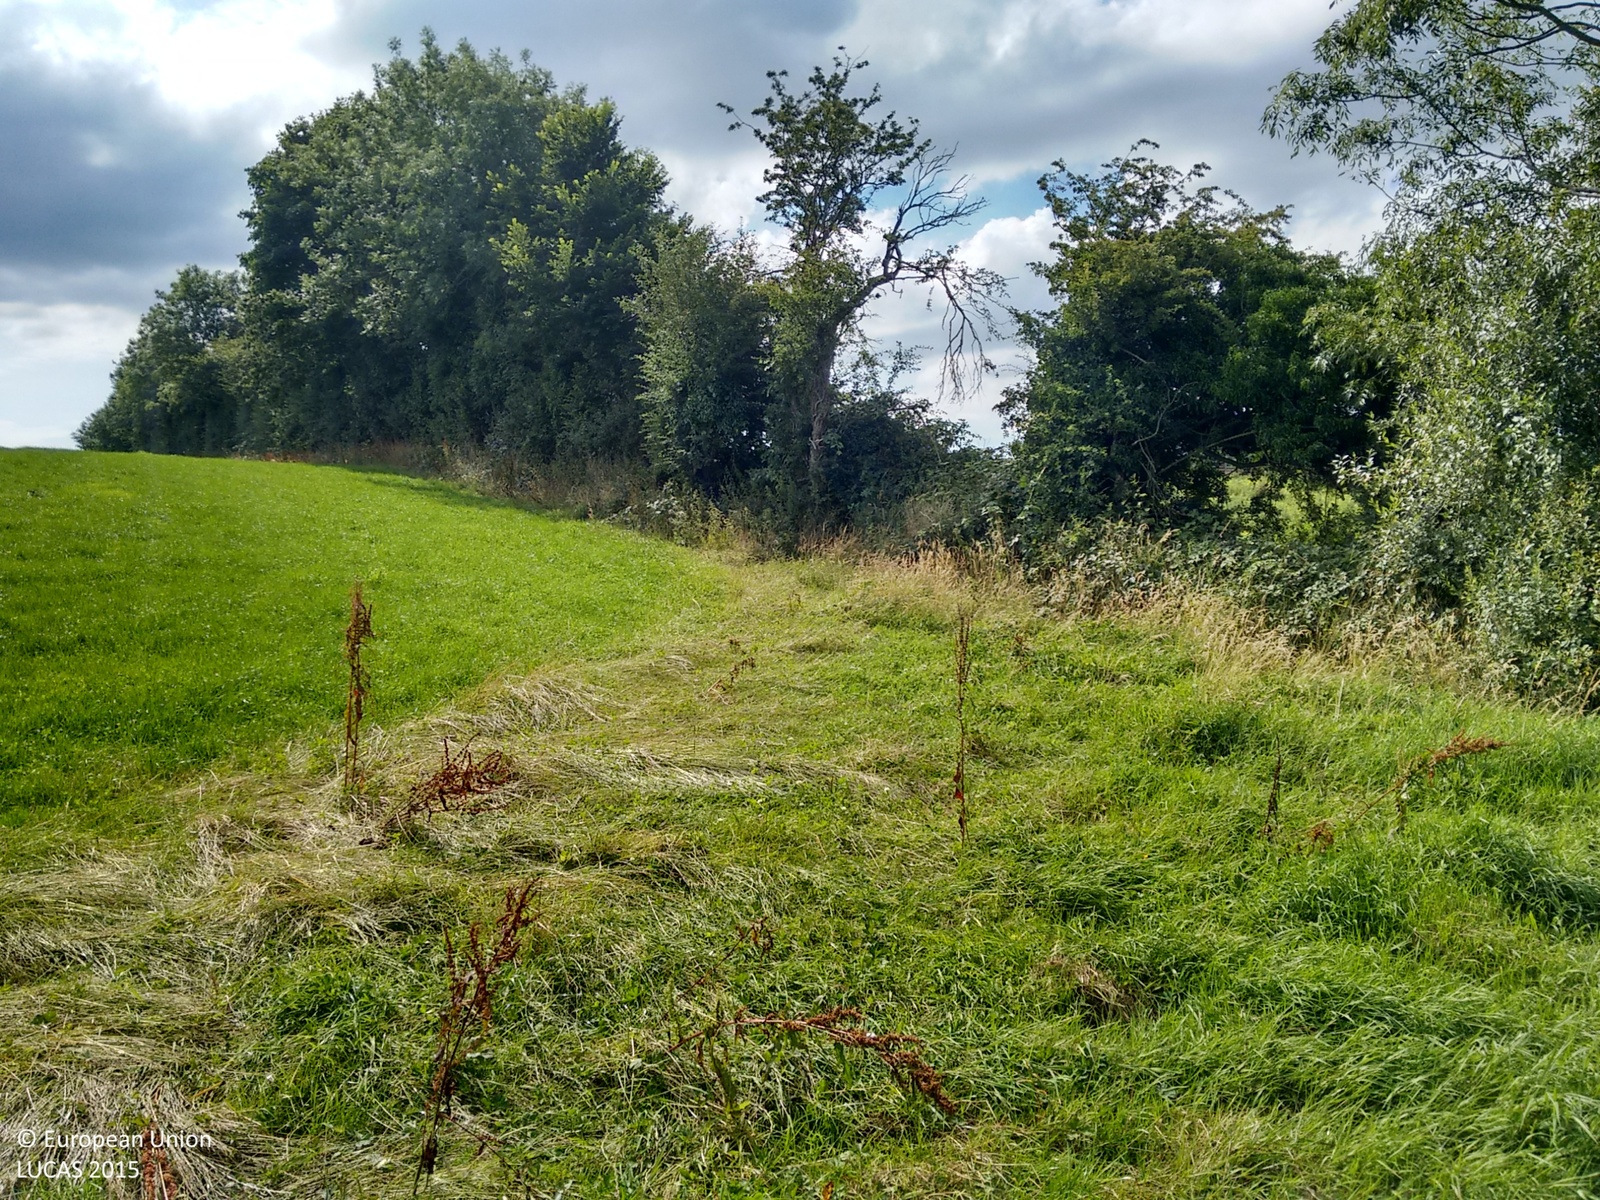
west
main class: Grassland
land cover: Grassland without tree/shrub cover
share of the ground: > 75 %
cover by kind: herbaceous plants 100 %
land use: Agriculture (excluding fallow land and kitchen gardens)
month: August
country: IE
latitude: 52.9643
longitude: -7.4728
